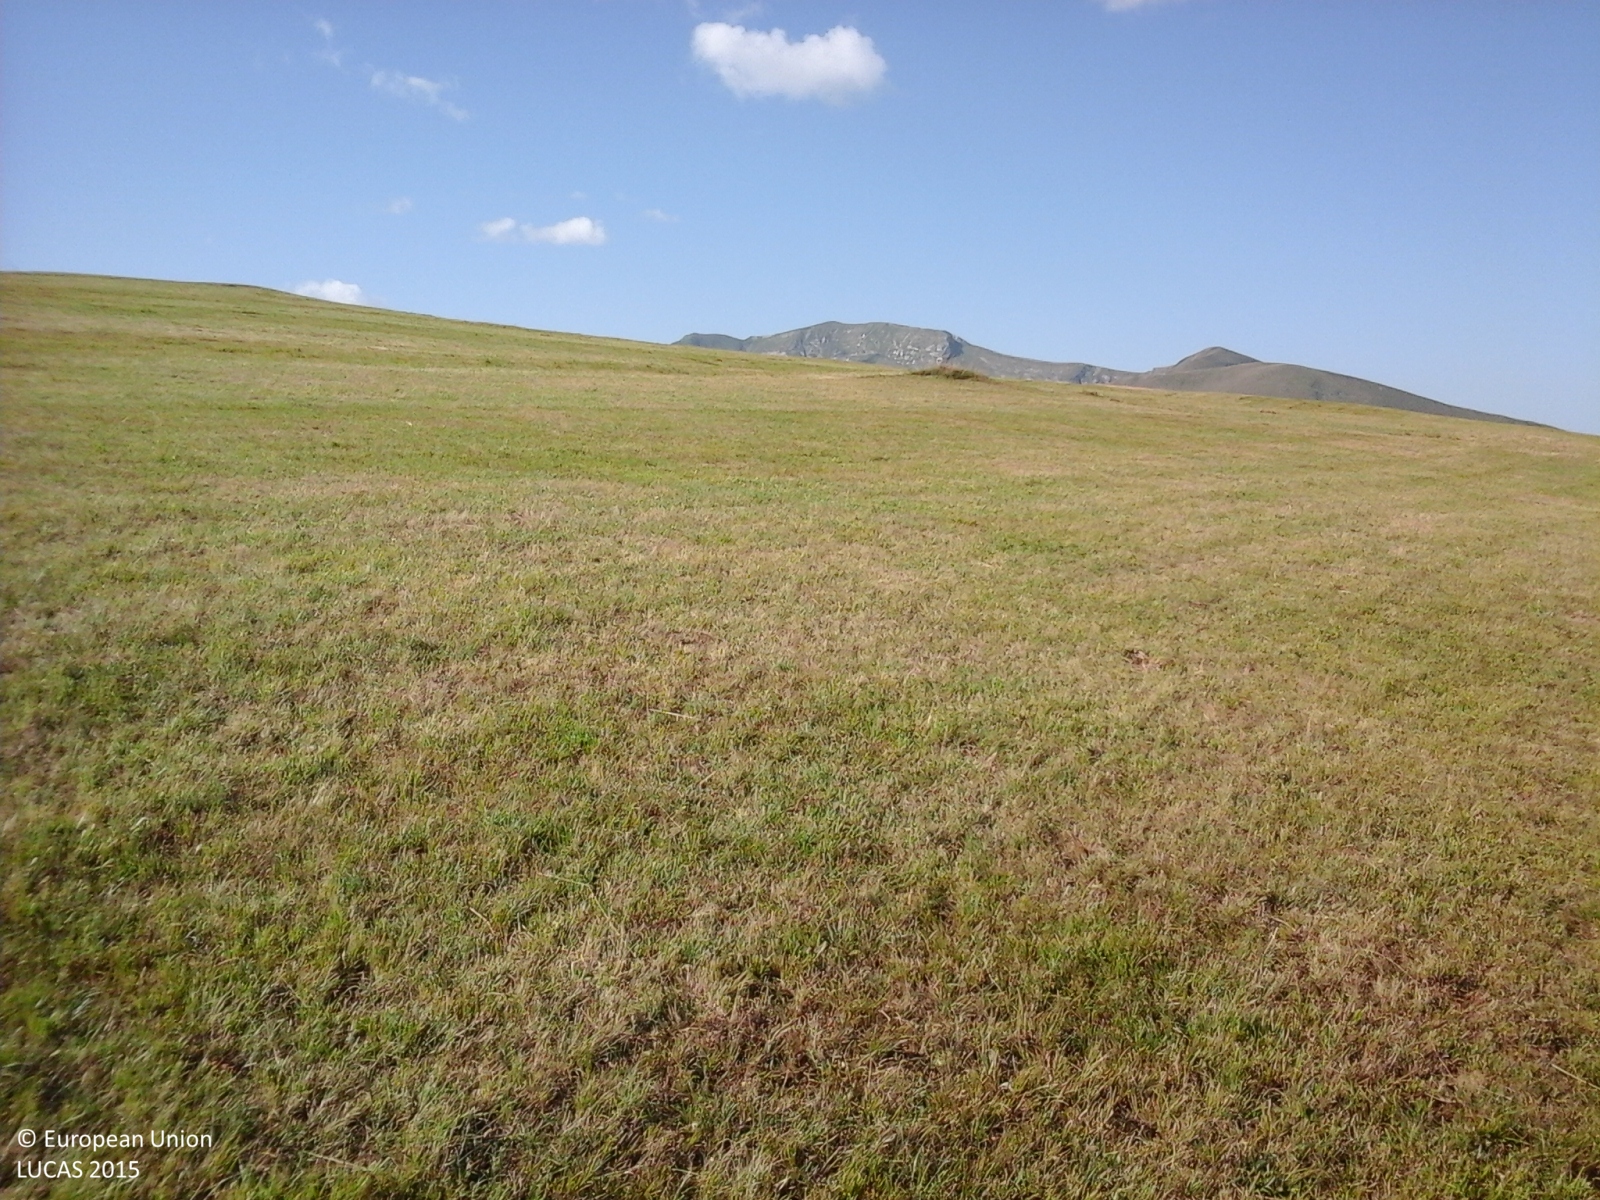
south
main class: Grassland
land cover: Grassland without tree/shrub cover
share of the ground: > 75 %
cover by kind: herbaceous plants 100 %
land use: Agriculture (excluding fallow land and kitchen gardens)
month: August
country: IT
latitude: 43.0185
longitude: 13.2181
